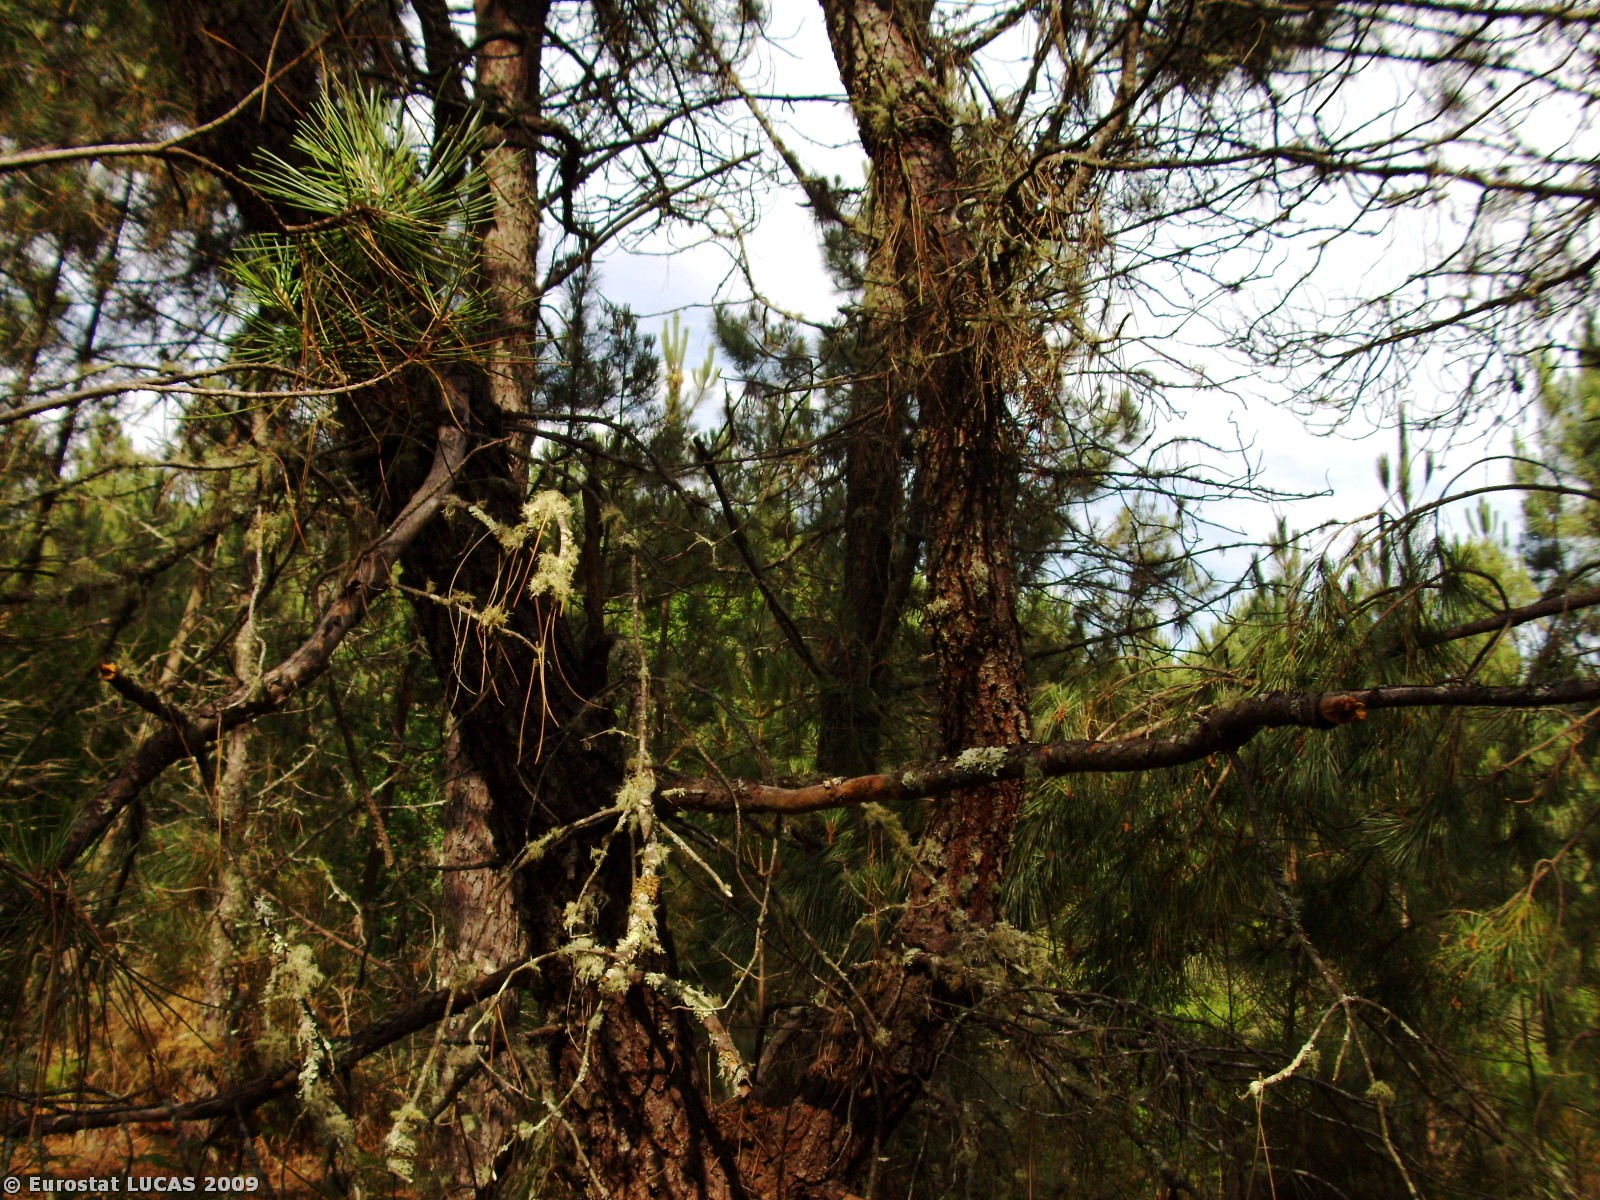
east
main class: Woodland
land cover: Coniferous woodland
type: coniferous forest of the mediterranean region
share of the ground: > 75 %
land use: Forestry
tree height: > 5 m
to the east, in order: Coniferous woodland; Shrubland without tree cover; Coniferous woodland; Tracks; Coniferous woodland; Shrubland without tree cover; Coniferous woodland; Shrubland with sparse tree cover; Tracks; Mixed woodland; Dry stone walls; Tracks
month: July
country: PT
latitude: 40.7294
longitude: -7.7027
